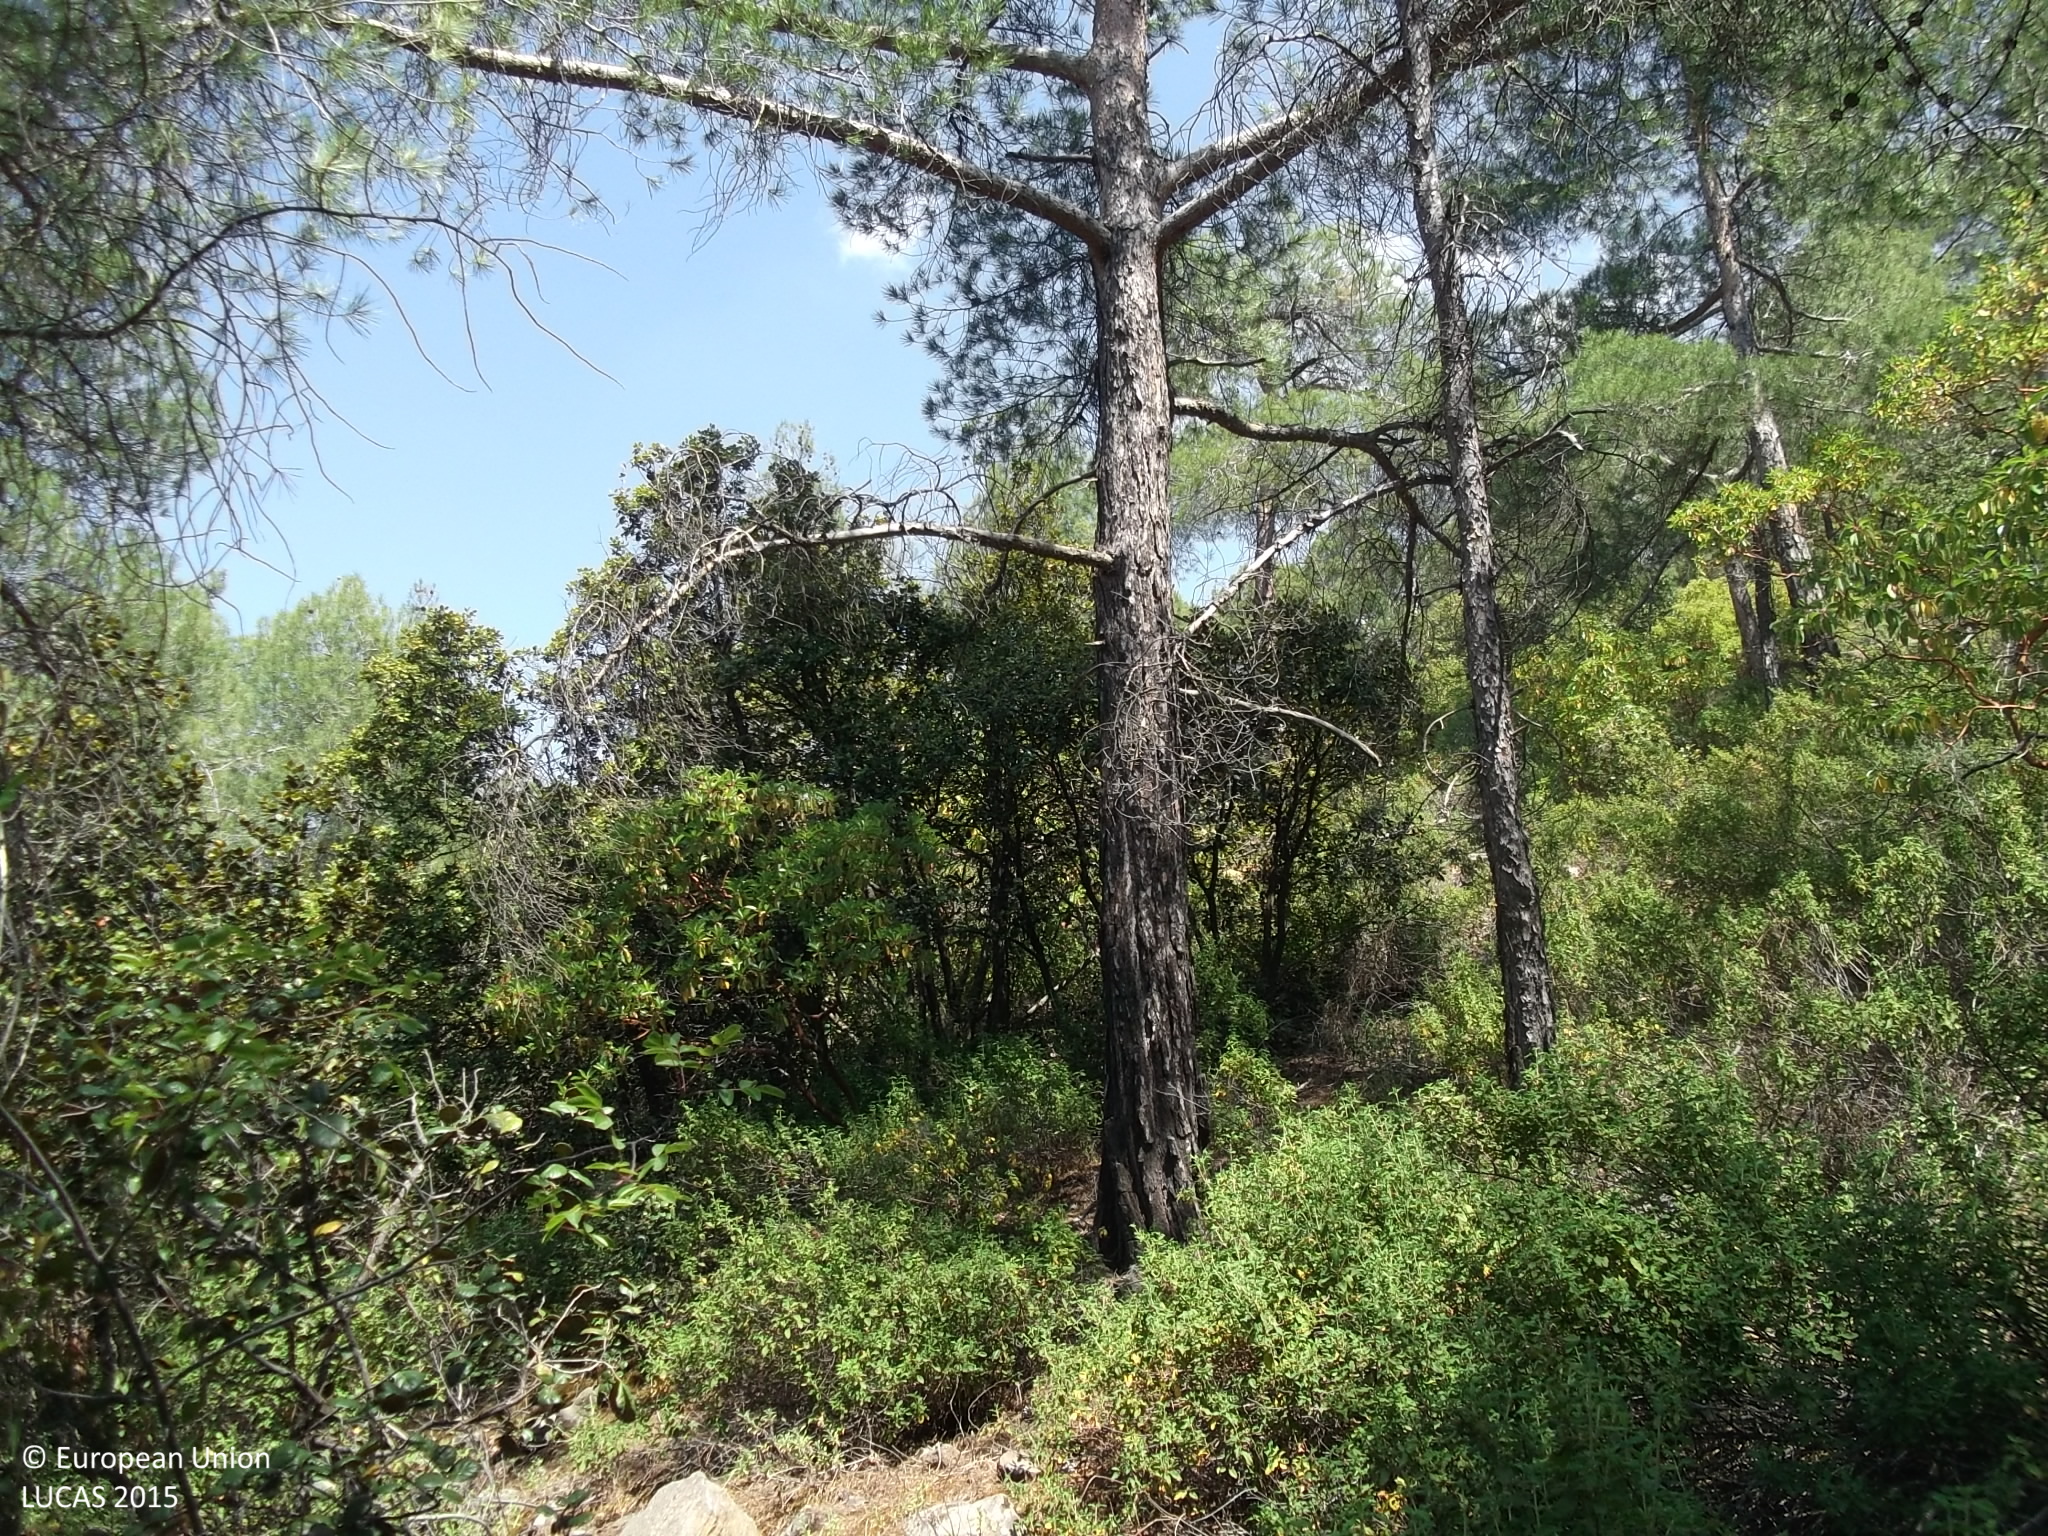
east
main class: Woodland
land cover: Other mixed woodland
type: coniferous forest of the mediterranean region
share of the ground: > 75 %
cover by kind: coniferous forest trees 75 %, broadleaved forest trees 25 %
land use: Forestry
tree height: > 5 m
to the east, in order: Other mixed woodland; Other bare soil; Pine dominated mixed woodland
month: June
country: CY
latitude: 34.9651
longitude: 32.9170
